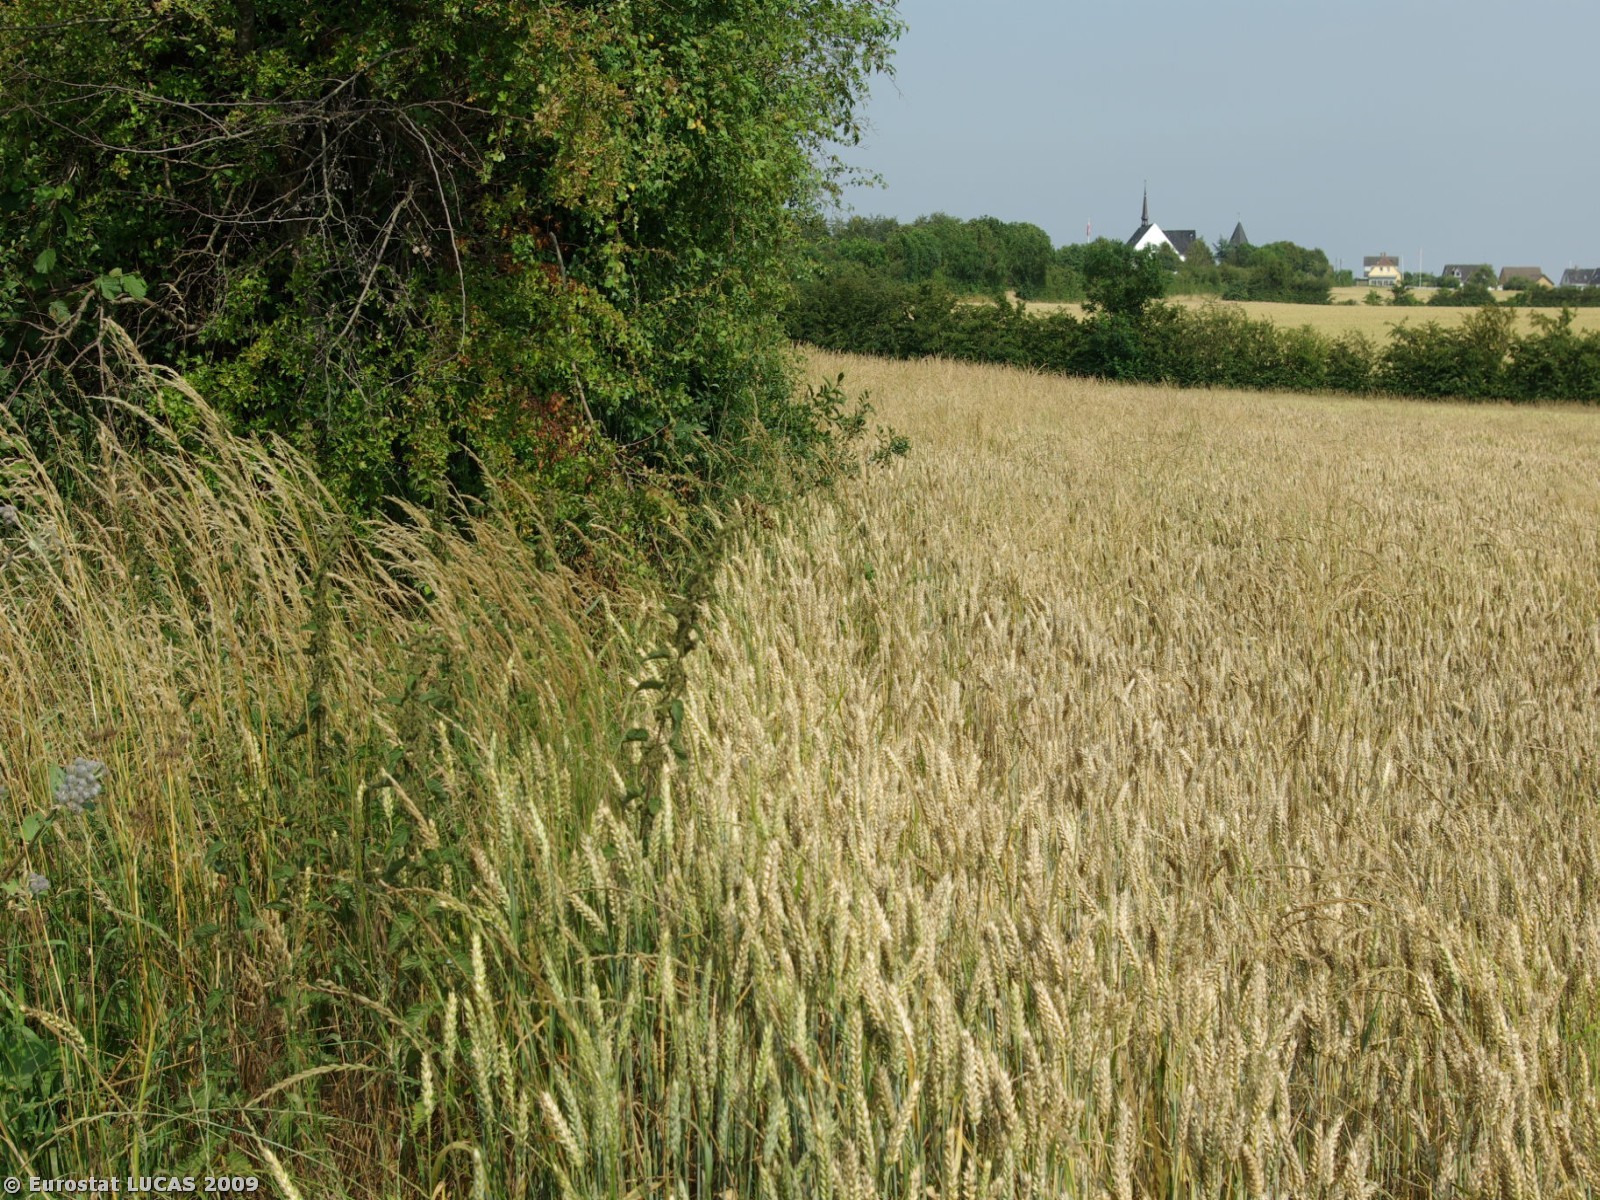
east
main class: Cropland
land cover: Common wheat
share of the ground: > 75 %
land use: Agriculture (excluding fallow land and kitchen gardens)
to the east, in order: Common wheat; Broadleaved woodland; Common wheat
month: July
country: DK
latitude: 54.9834
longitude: 9.8595
